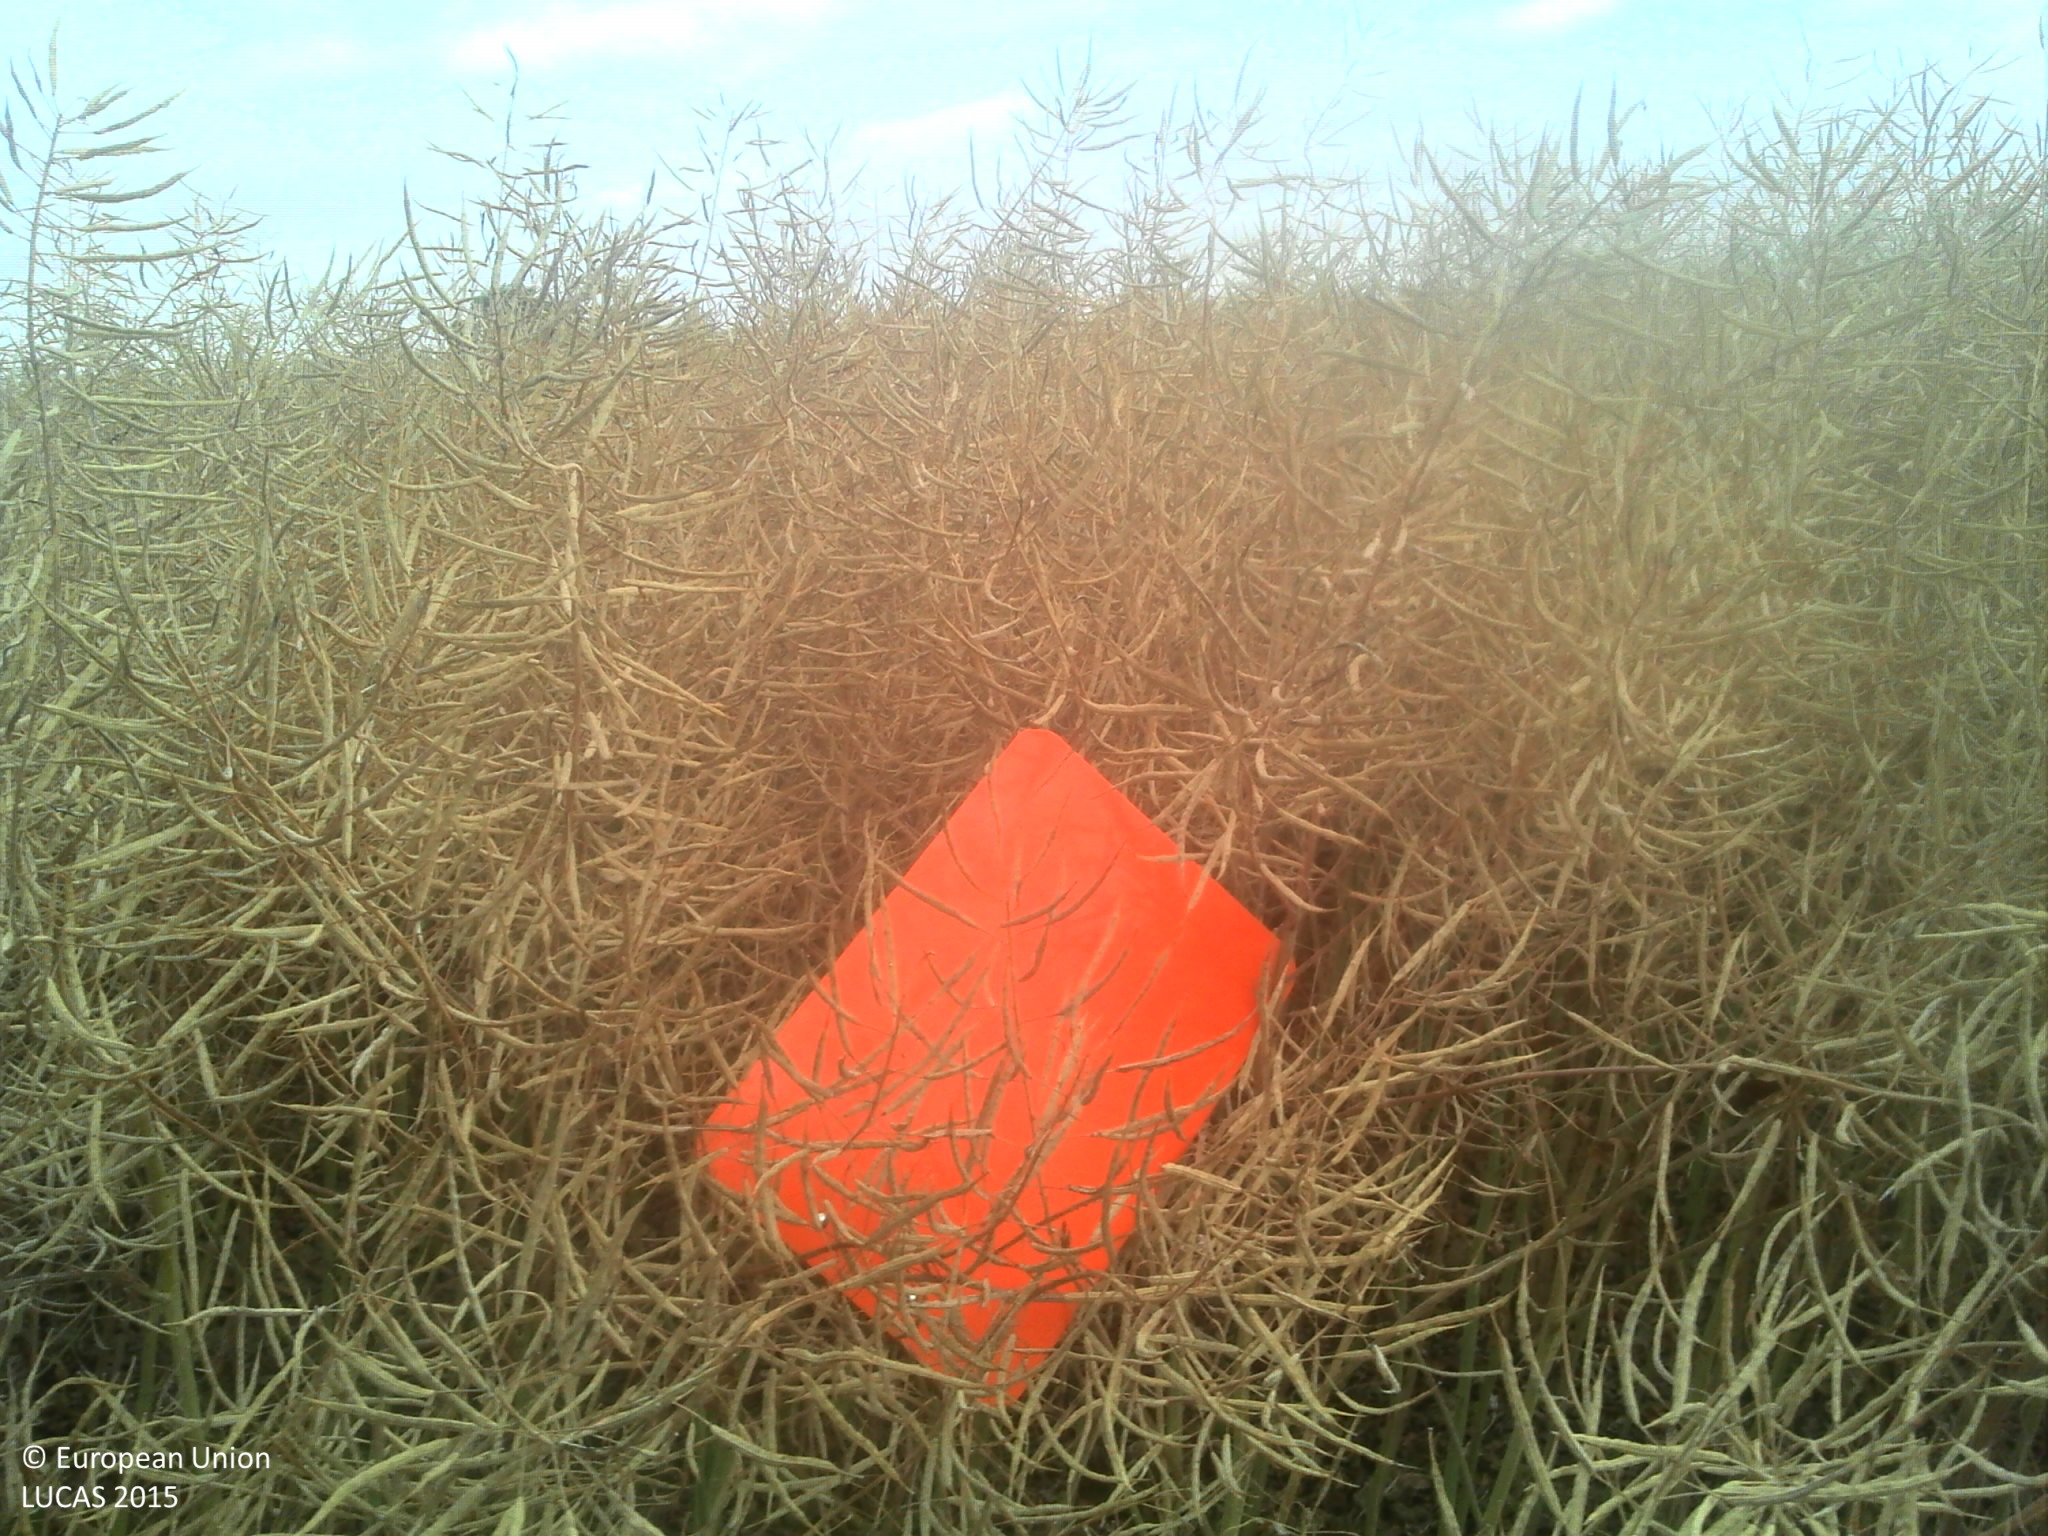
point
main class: Cropland
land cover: Rape and turnip rape
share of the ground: > 75 %
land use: Agriculture (excluding fallow land and kitchen gardens)
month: July
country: FR
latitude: 47.9338
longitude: 1.0803
